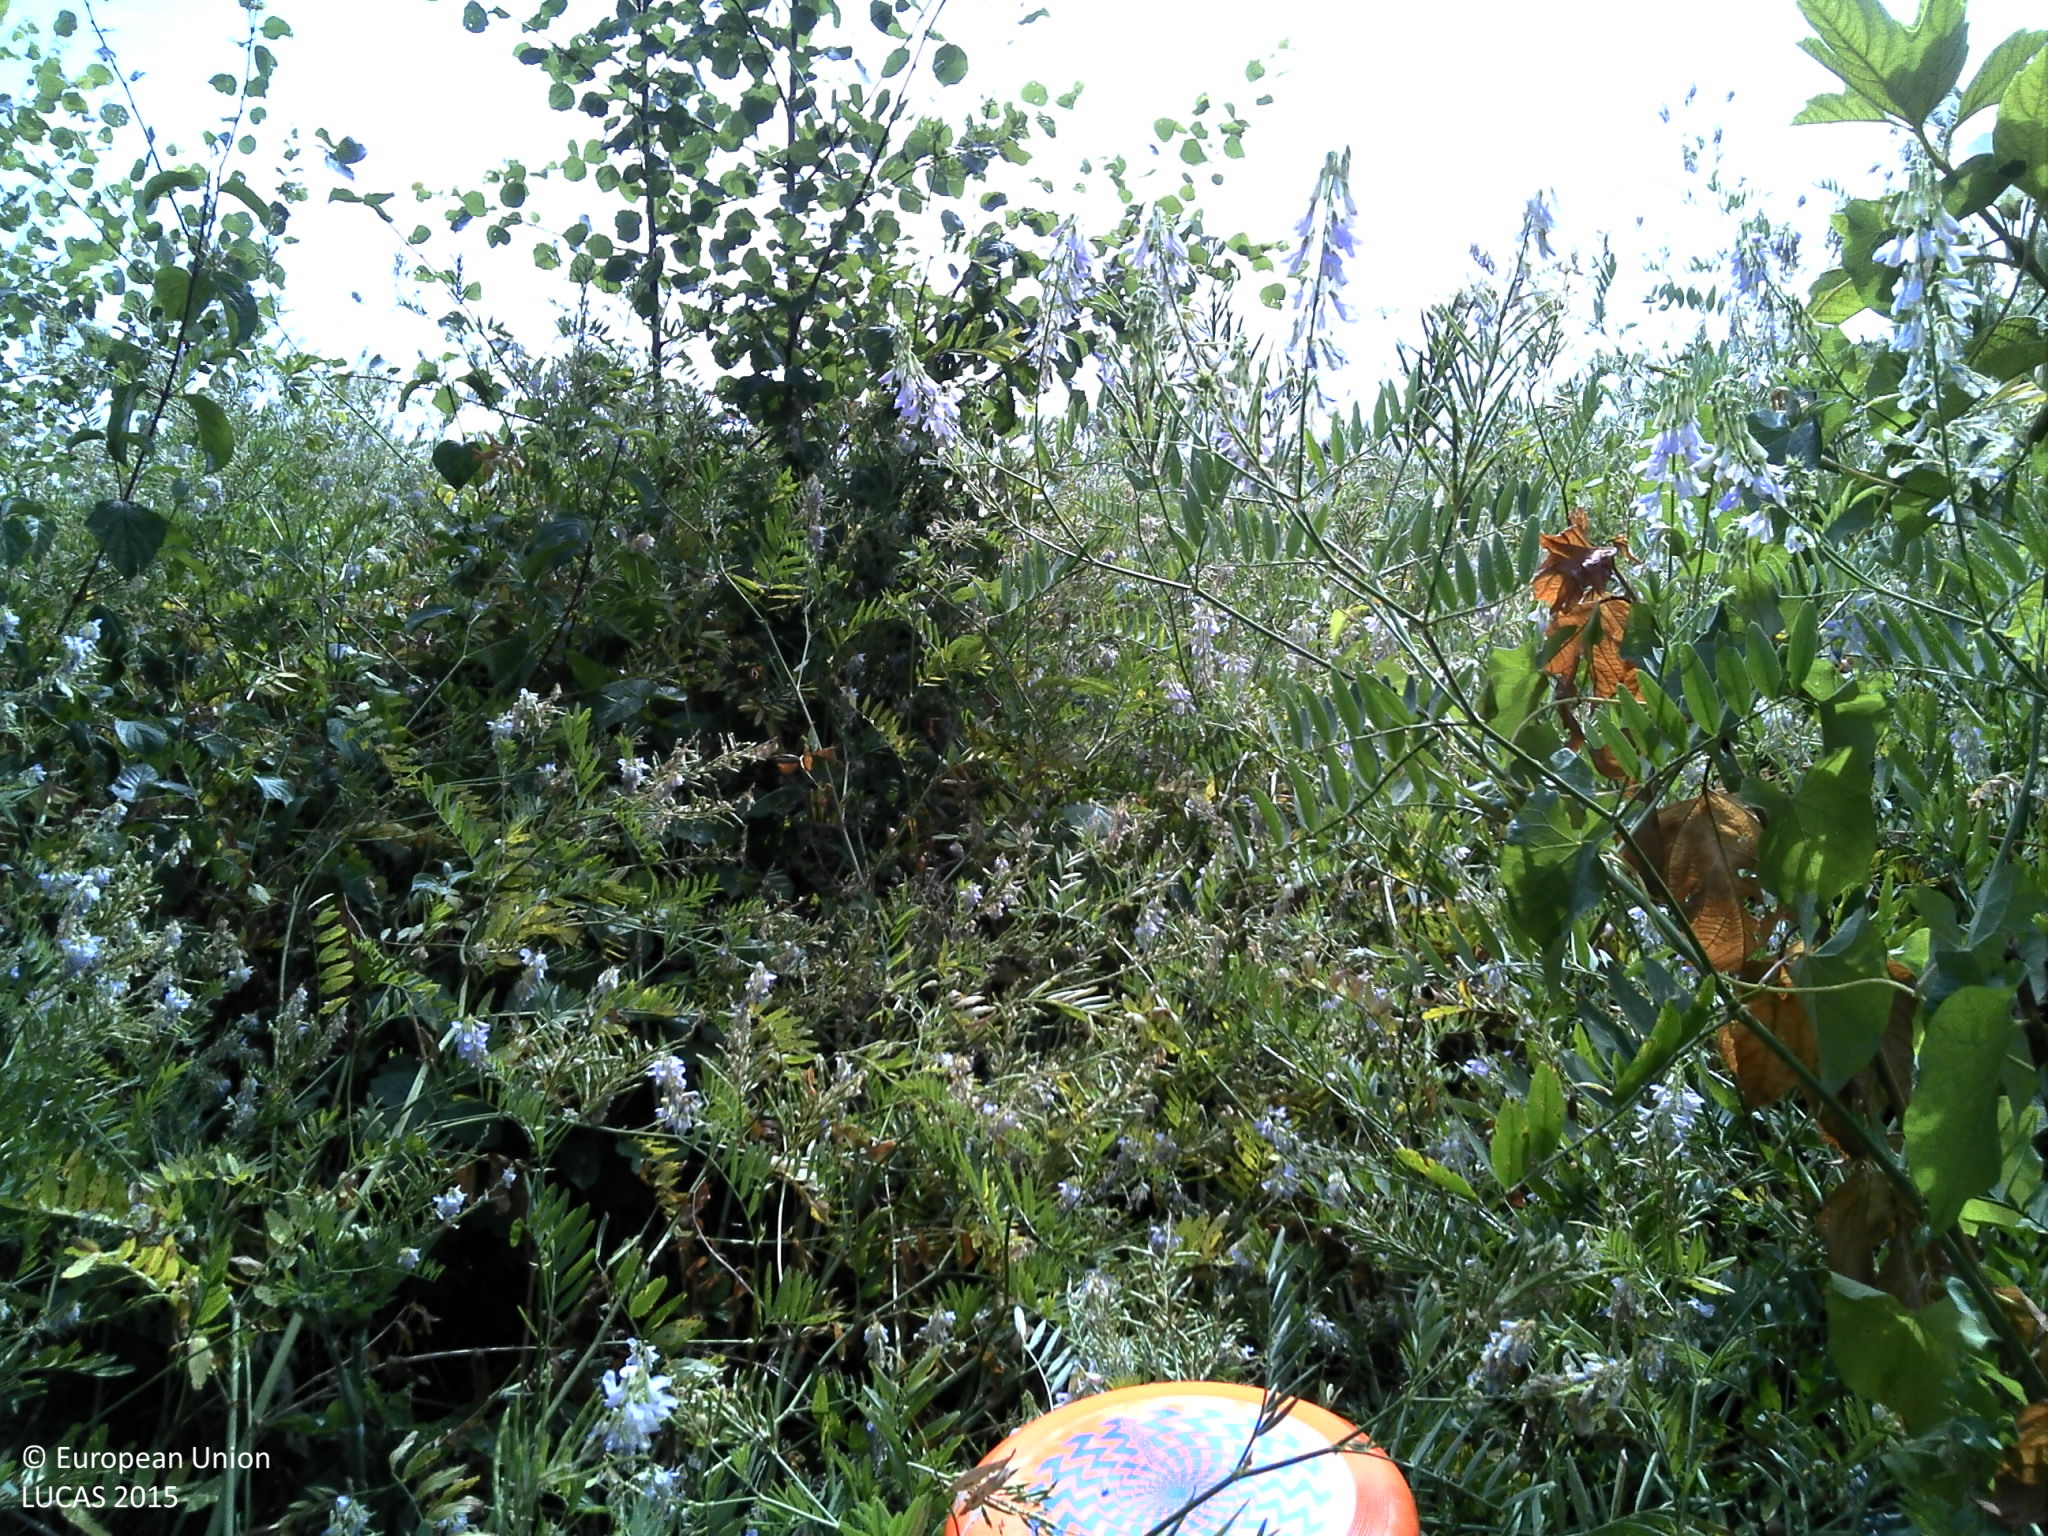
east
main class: Grassland
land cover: Spontaneously vegetated surfaces
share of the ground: > 75 %
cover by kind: herbaceous plants 95 %, shrubs 5 %
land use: Semi-natural and natural areas not in use
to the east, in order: Spontaneously vegetated surfaces; Other leguminous and mixtures for fodder
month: July
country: FR
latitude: 48.8992
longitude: 4.9096
